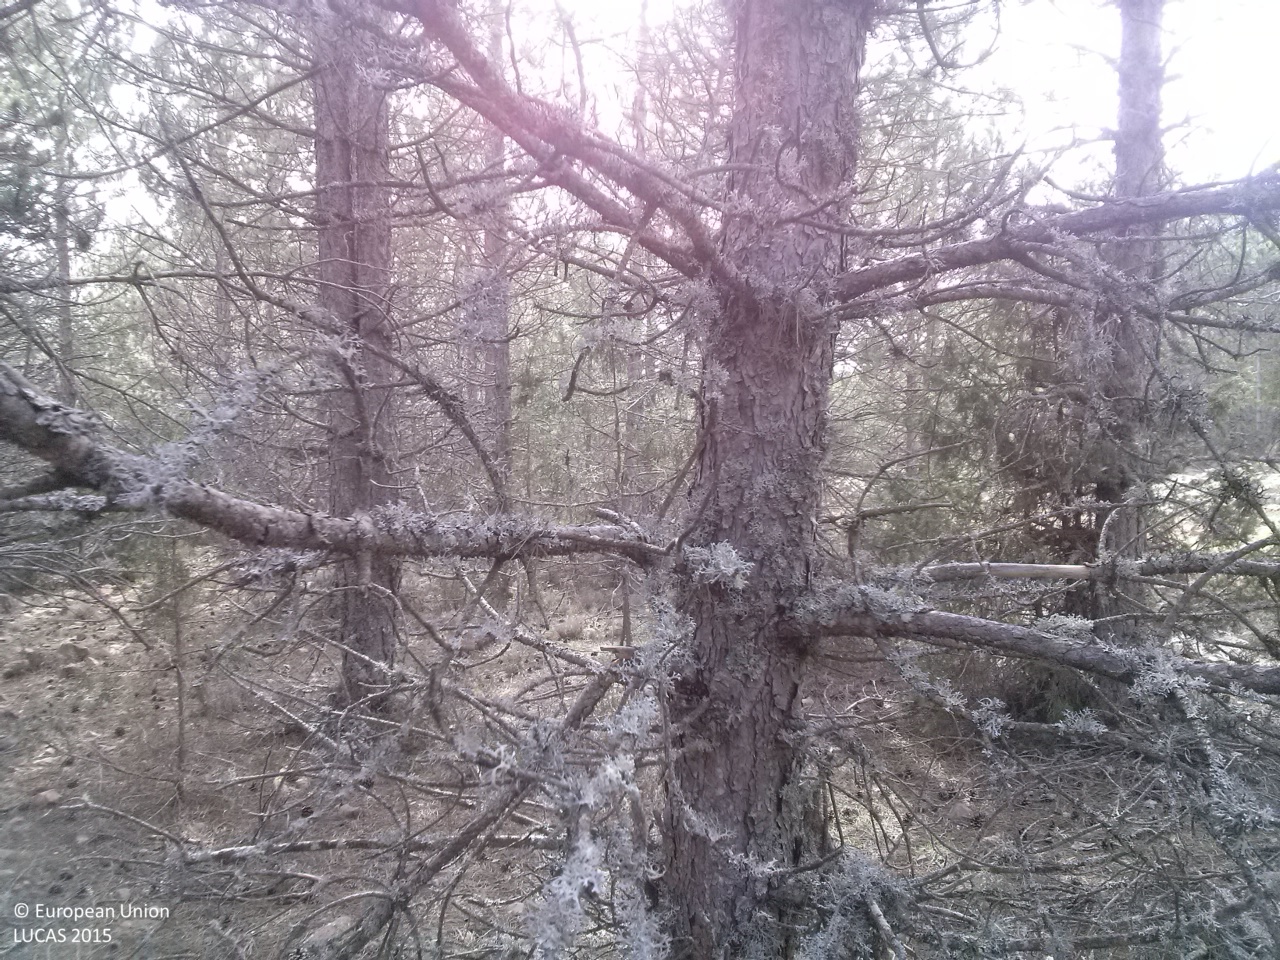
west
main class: Woodland
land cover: Pine dominated coniferous woodland
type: coniferous forest of the mediterranean region
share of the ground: 50 - 75 %
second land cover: Grassland without tree/shrub cover
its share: 10 - 25 %
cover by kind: coniferous forest trees 70 %, herbaceous plants 25 %, shrubs 5 %
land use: Forestry
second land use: Agriculture (excluding fallow land and kitchen gardens)
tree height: > 5 m
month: April
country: ES
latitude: 40.0918
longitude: -1.8717
